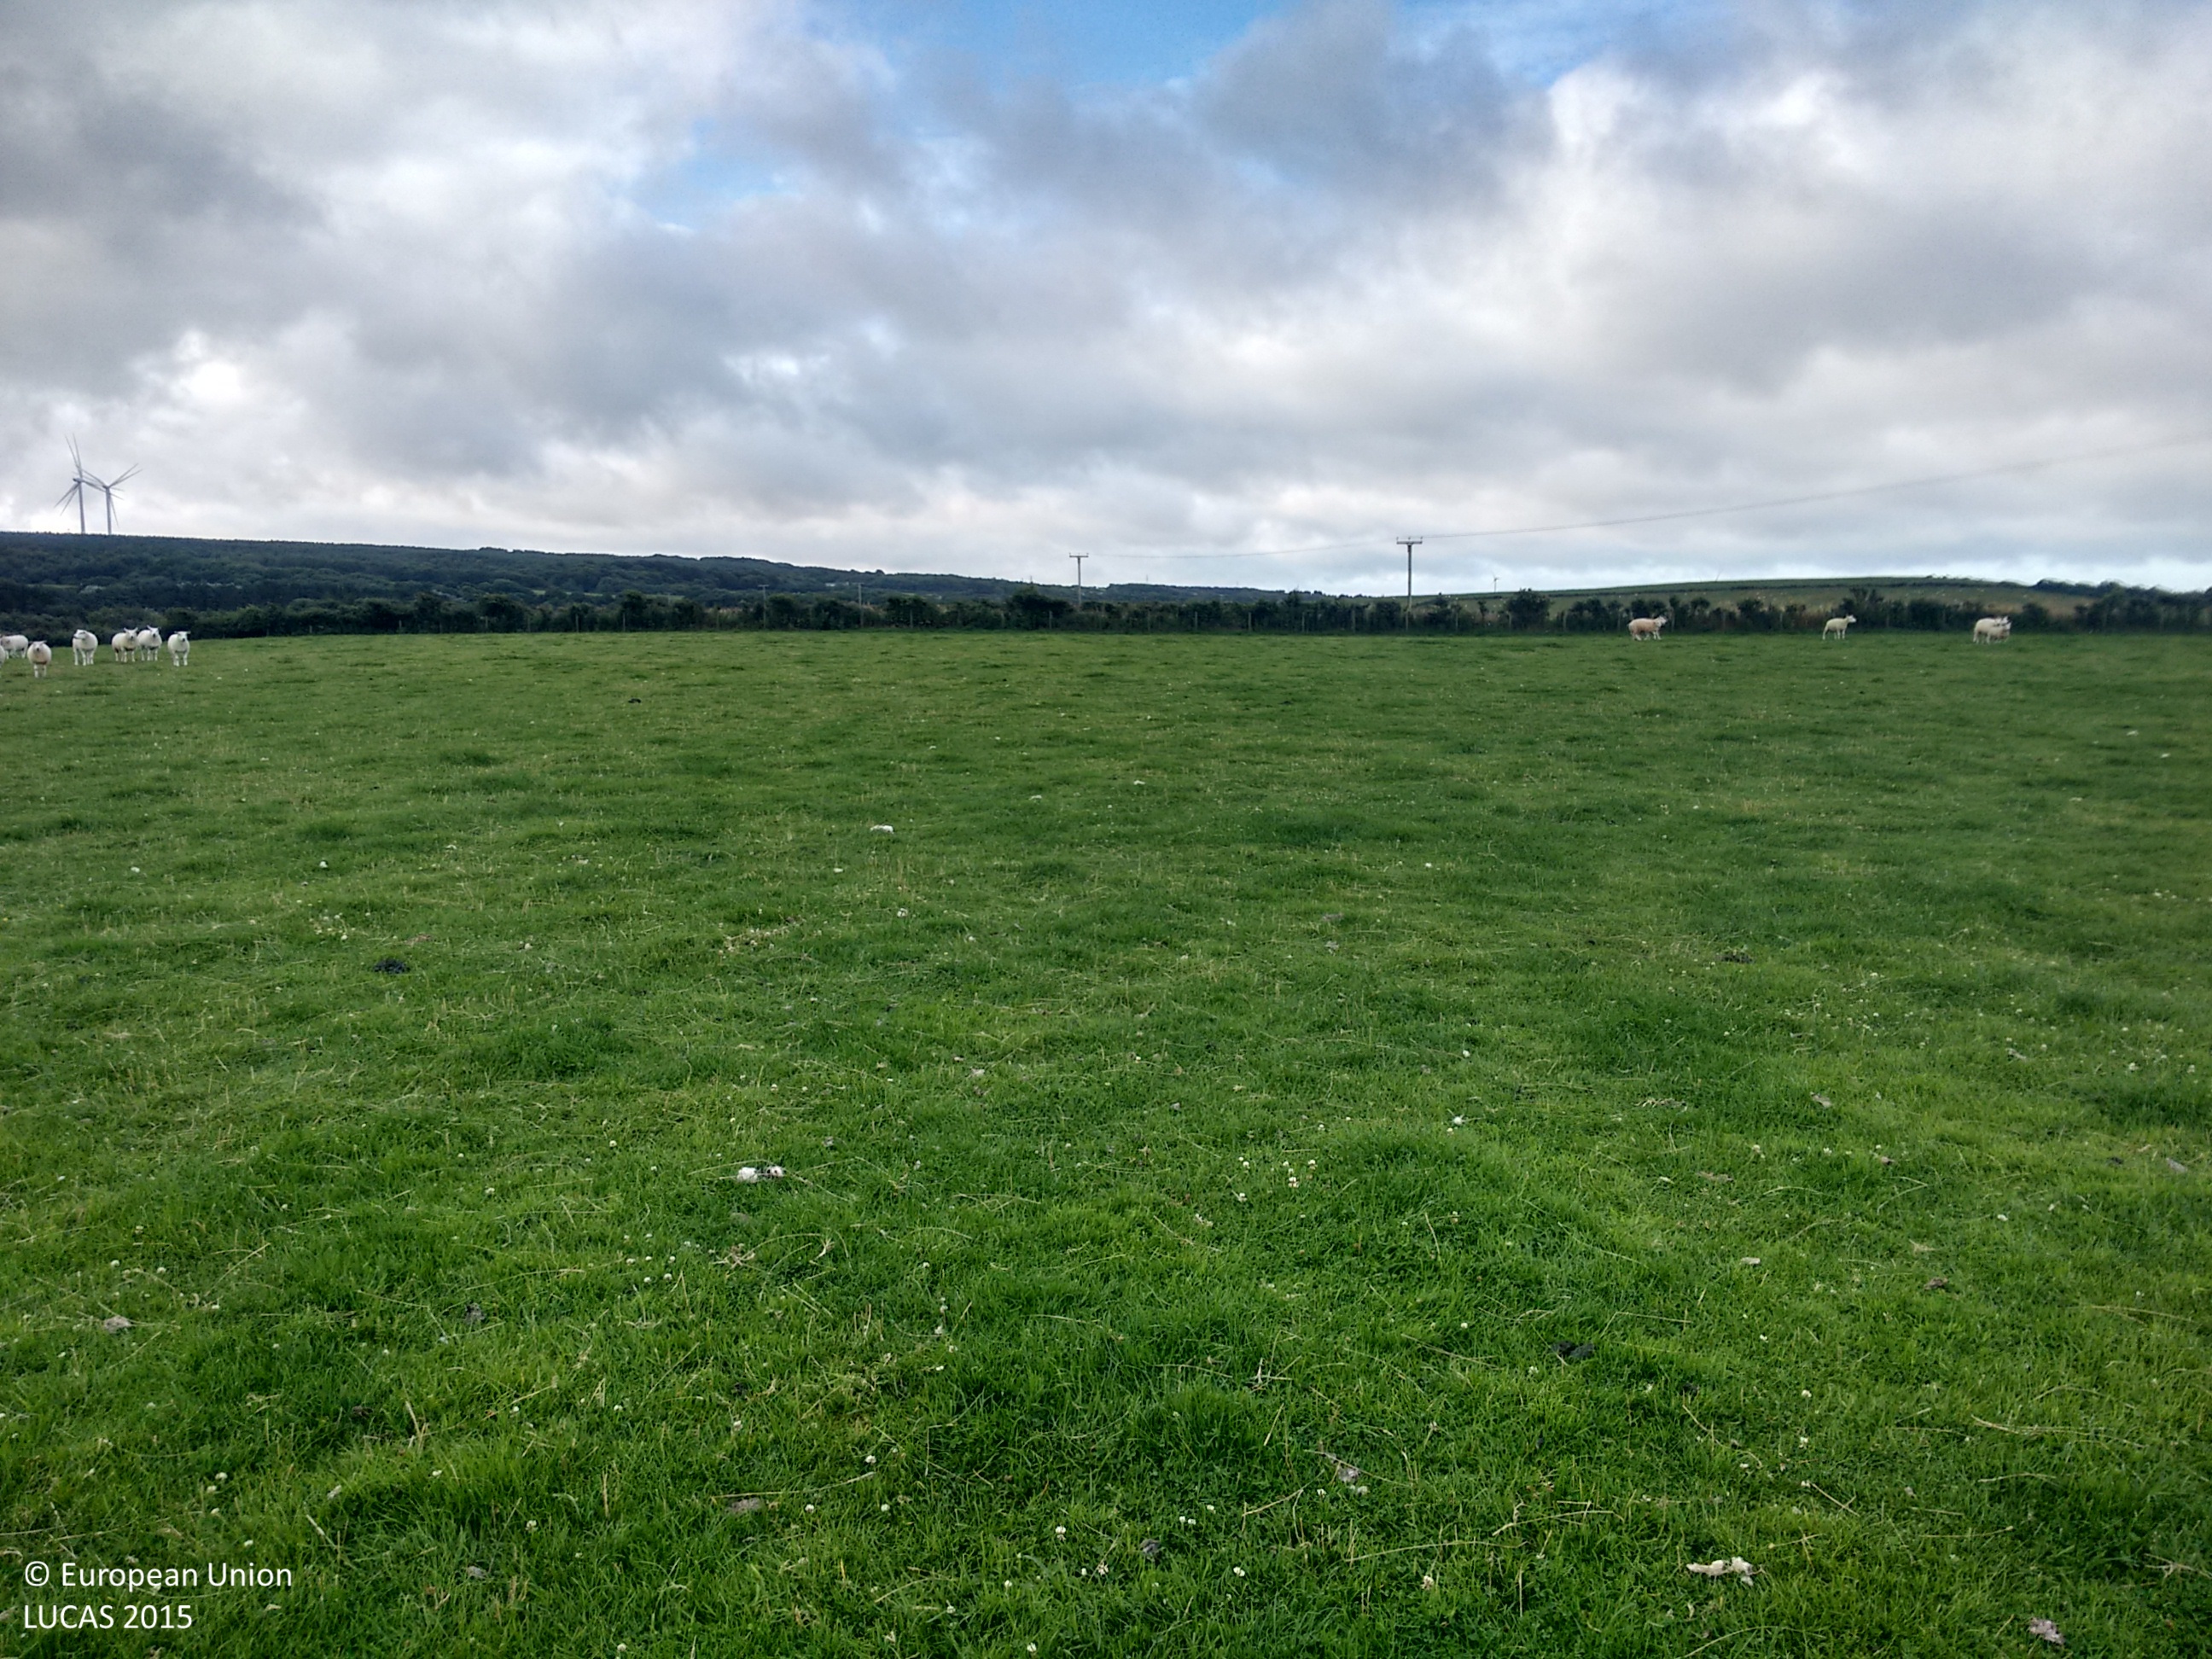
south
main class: Grassland
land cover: Grassland without tree/shrub cover
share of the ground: > 75 %
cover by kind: herbaceous plants 100 %
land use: Agriculture (excluding fallow land and kitchen gardens)
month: August
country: GB
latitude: 54.7027
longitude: -3.5049
